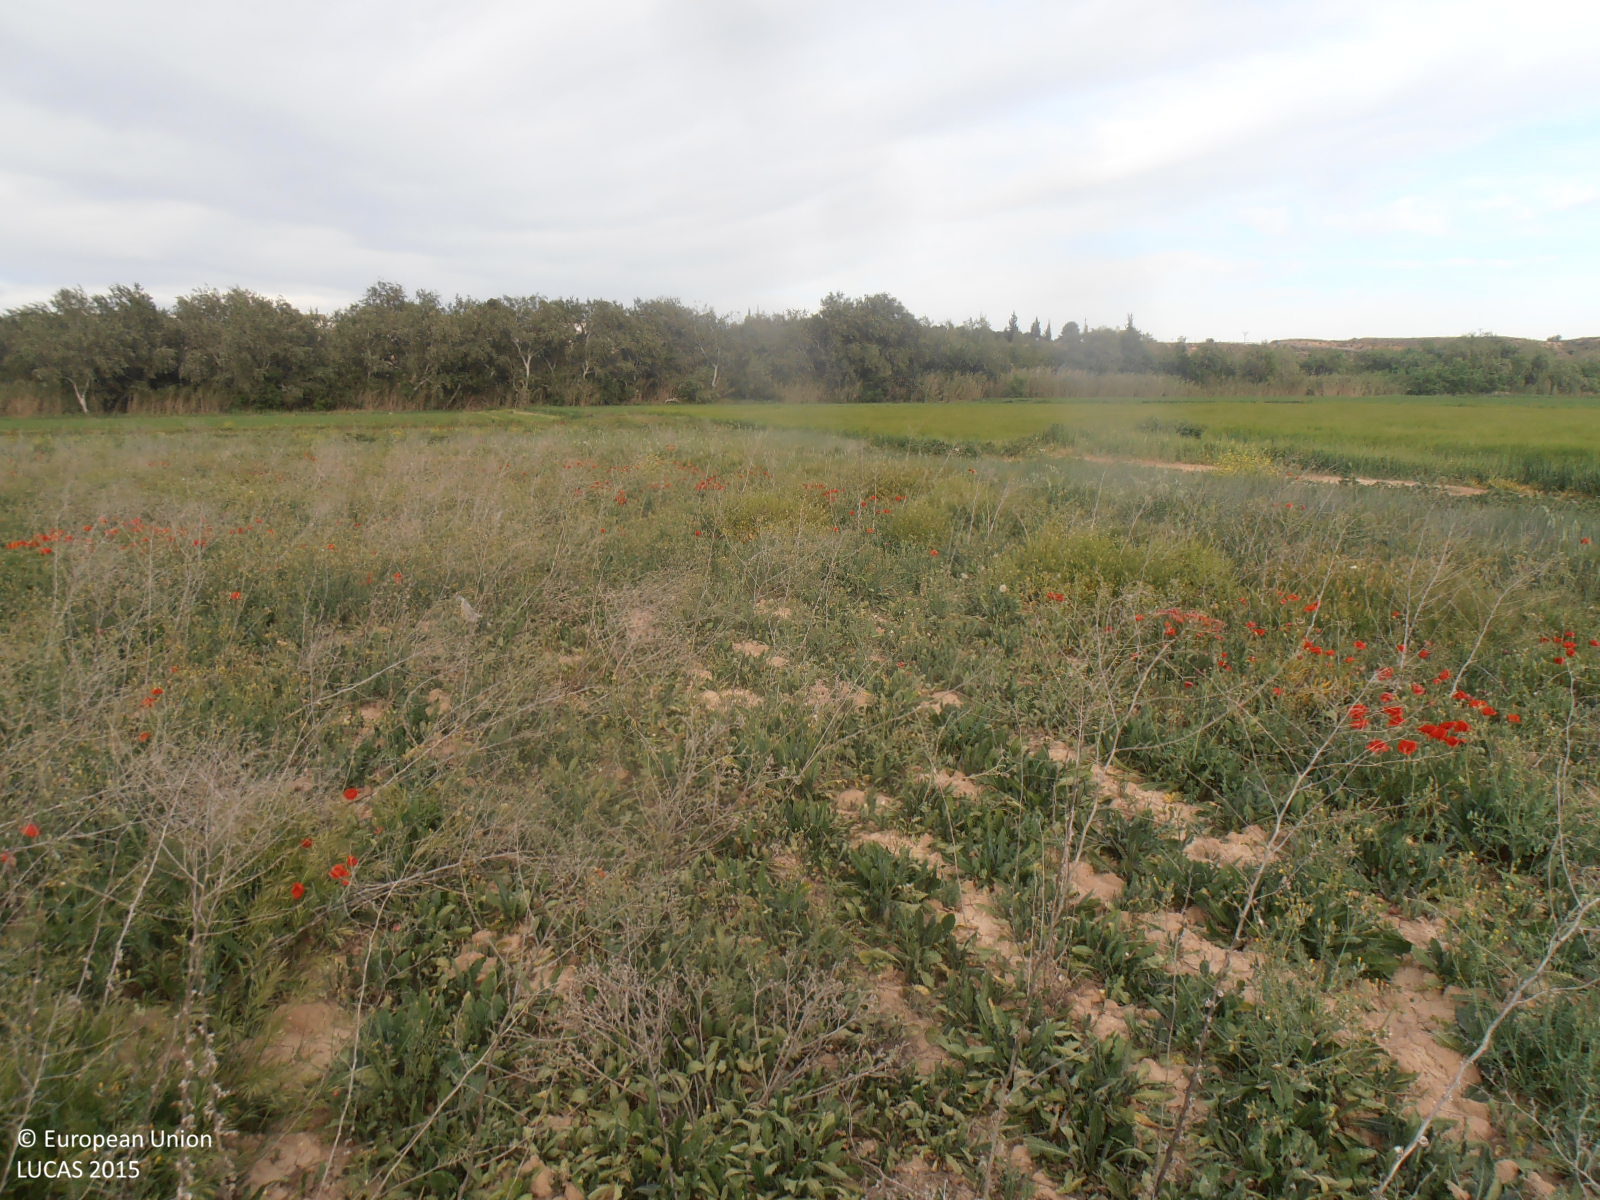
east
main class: Grassland
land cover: Spontaneously vegetated surfaces
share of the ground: > 75 %
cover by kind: herbaceous plants 100 %
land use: Fallow land
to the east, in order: Spontaneously vegetated surfaces; Grass margins; Spontaneously vegetated surfaces; Tracks; Grass margins; Barley; Grass margins; Barley; Grass margins; Common wheat; Grass margins; Tracks; Broadleaved woodland; Inland fresh running water
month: April
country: ES
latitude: 41.3371
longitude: -0.3757
